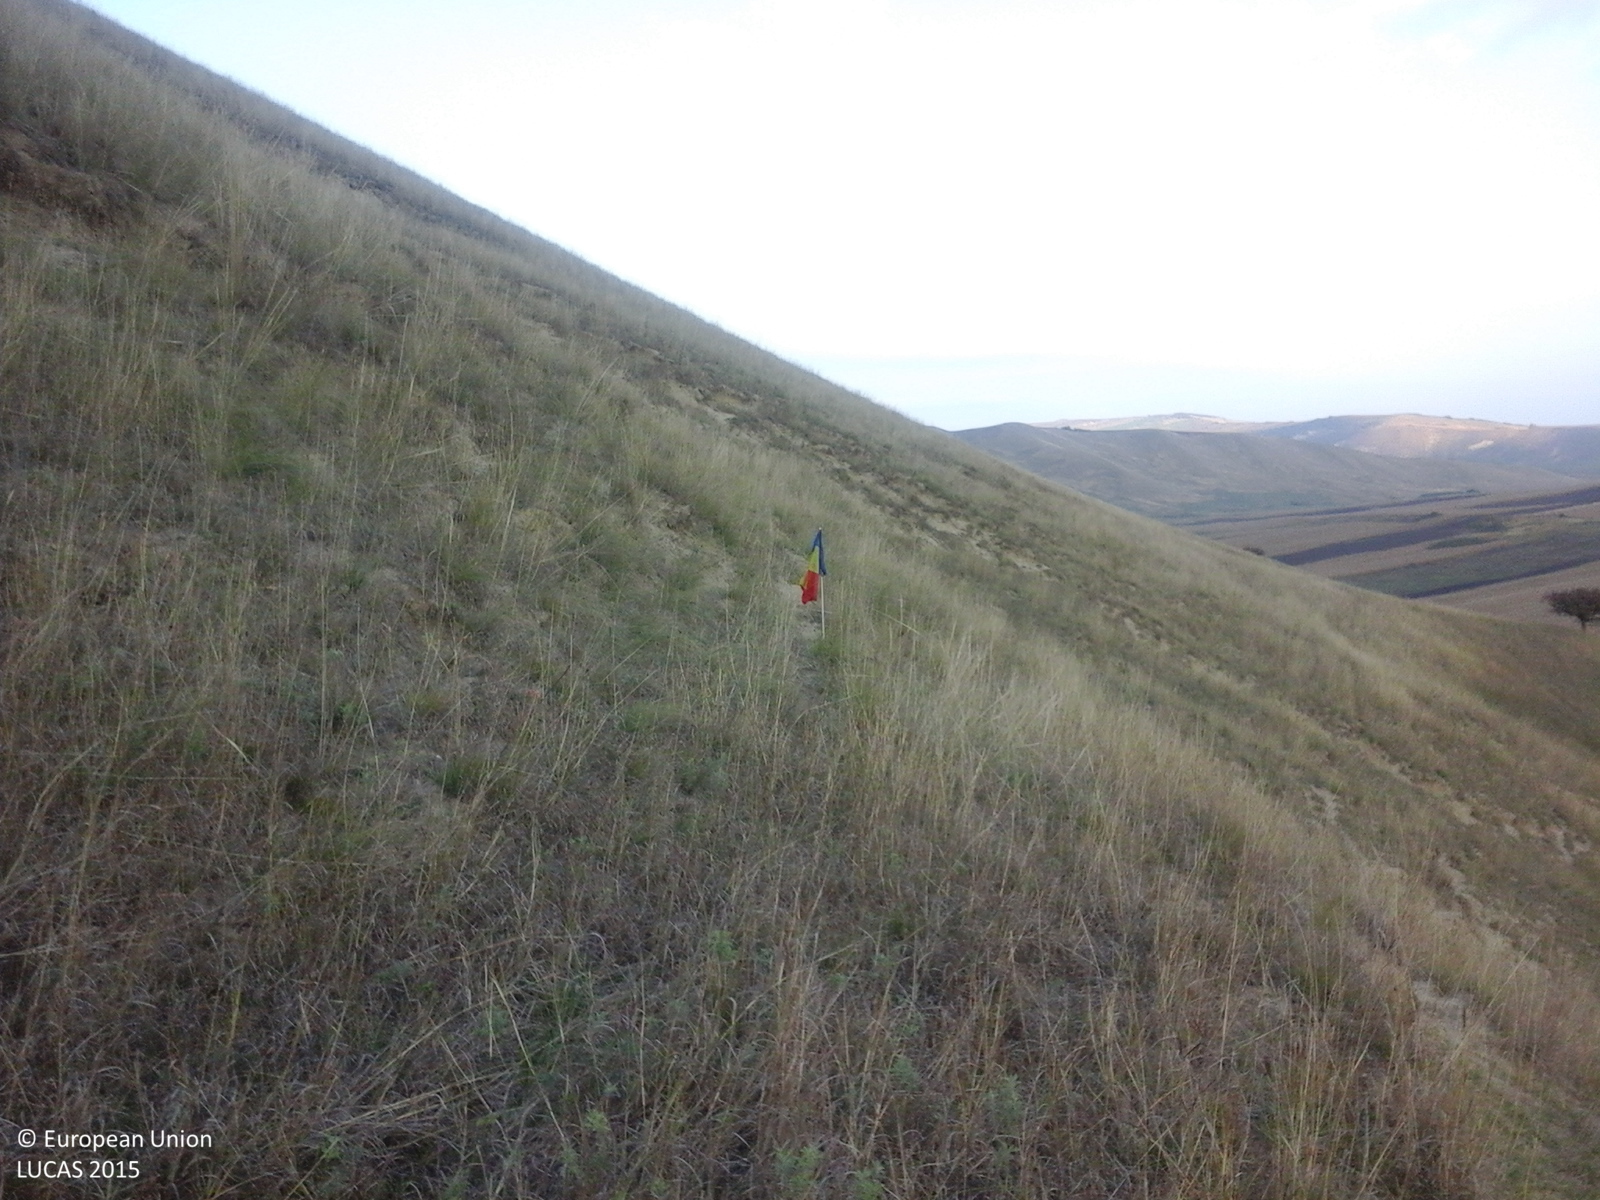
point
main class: Grassland
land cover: Grassland without tree/shrub cover
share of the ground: > 75 %
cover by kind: herbaceous plants 100 %
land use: Agriculture (excluding fallow land and kitchen gardens)
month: October
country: RO
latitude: 46.2582
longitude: 23.9157
